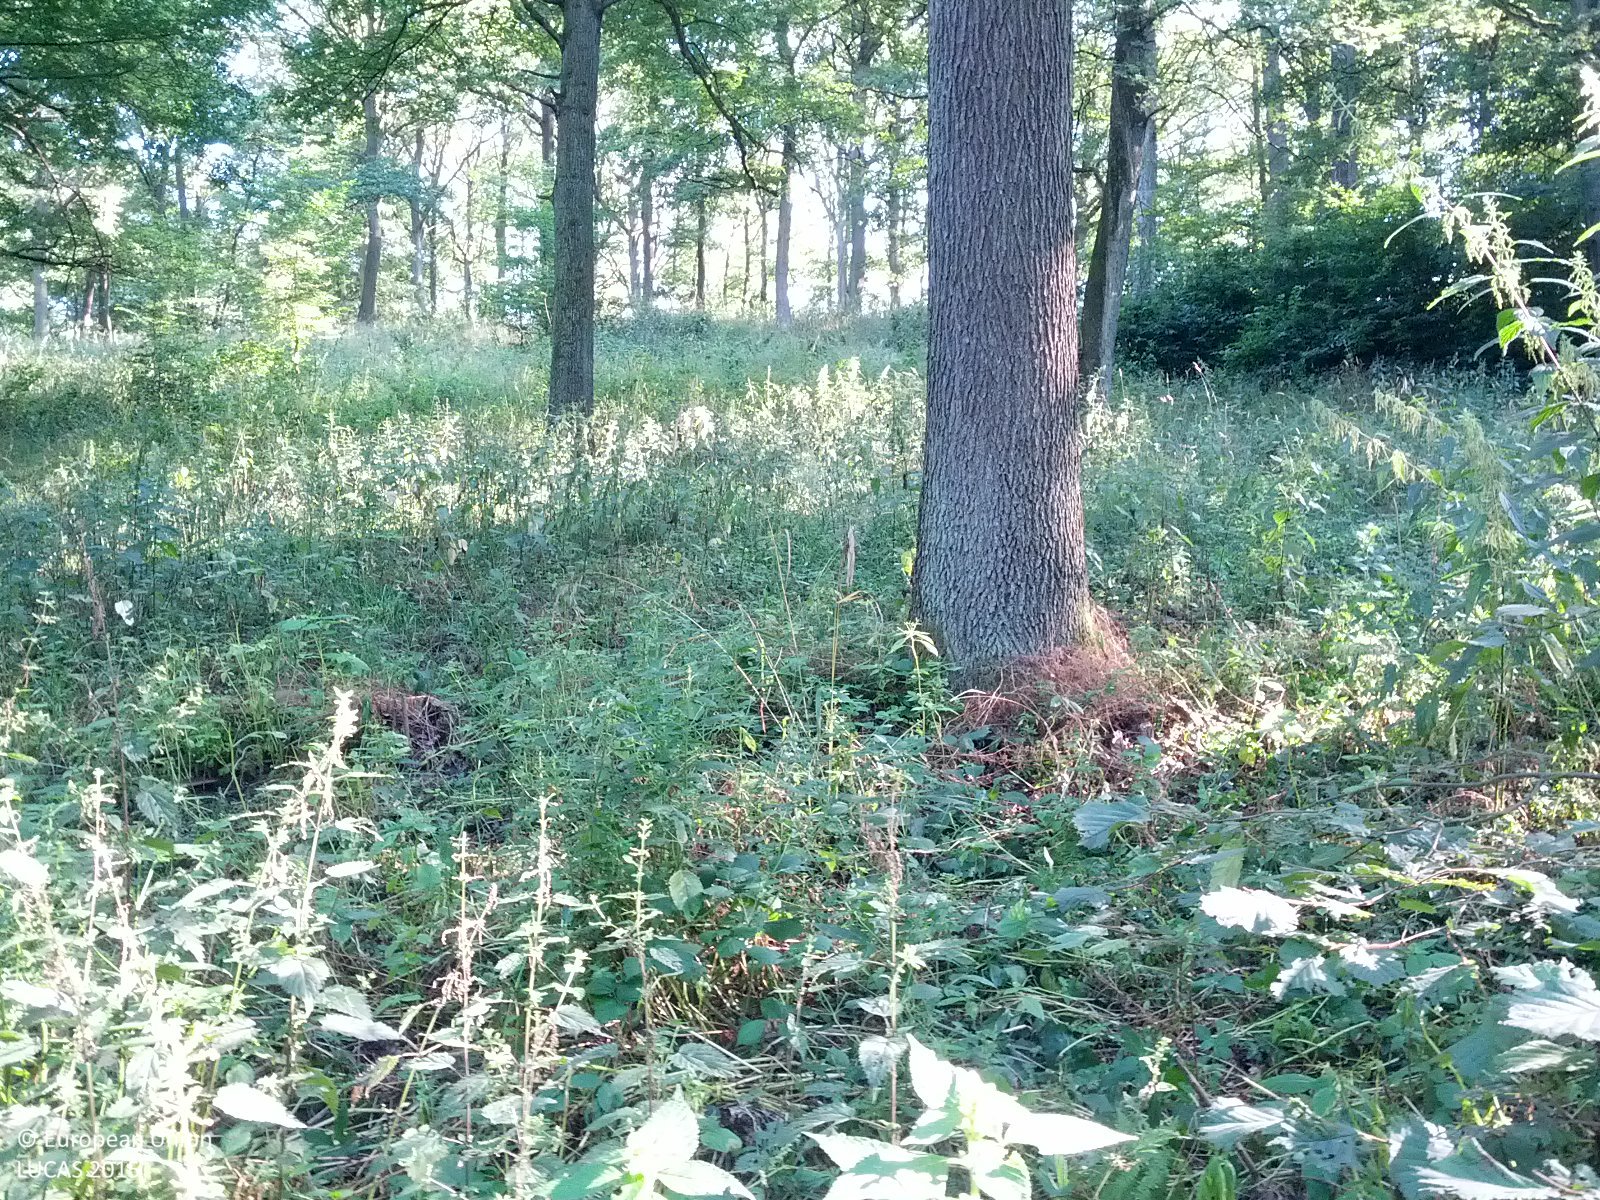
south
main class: Woodland
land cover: Broadleaved woodland
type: acidophilous oak and oak-birch forest
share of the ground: > 75 %
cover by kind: broadleaved forest trees 80 %, herbaceous plants 20 %
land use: Forestry
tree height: > 5 m
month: July
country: AT
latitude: 48.5499
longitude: 16.2775
